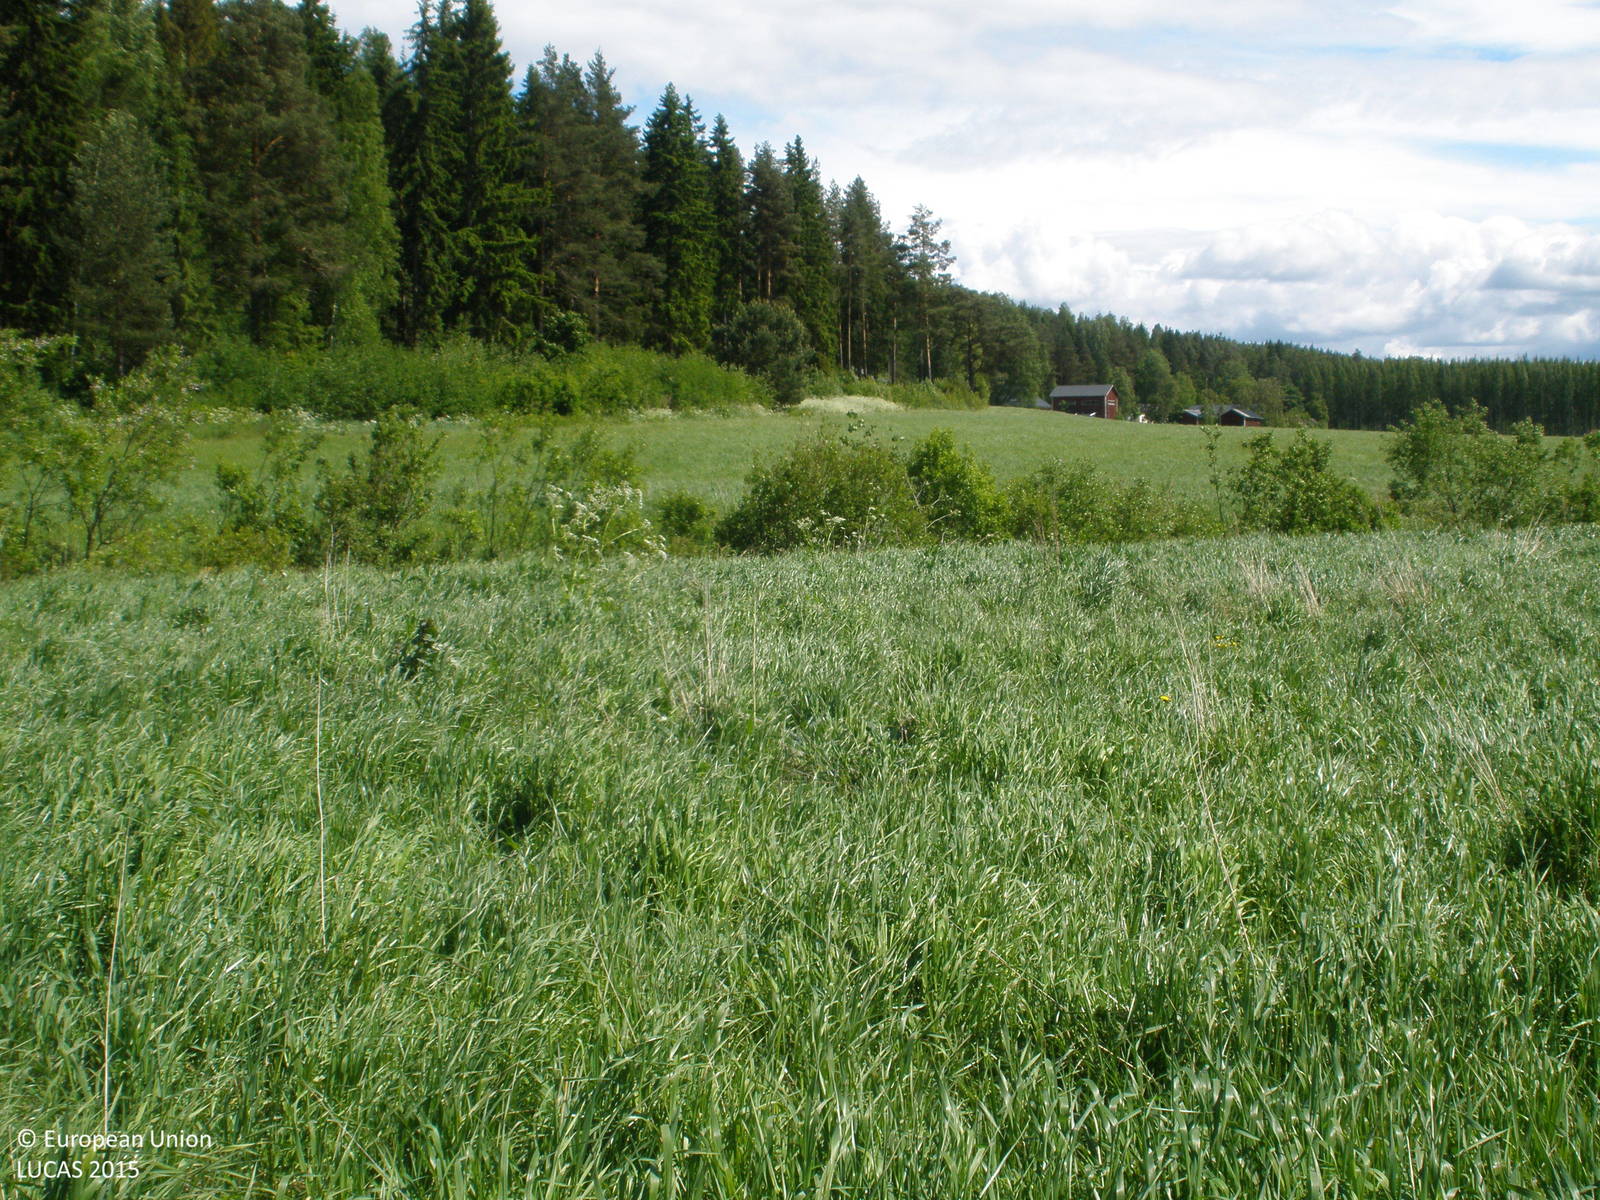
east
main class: Grassland
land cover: Grassland without tree/shrub cover
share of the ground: > 75 %
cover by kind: herbaceous plants 100 %
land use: Agriculture (excluding fallow land and kitchen gardens)
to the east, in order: Grassland without tree/shrub cover; Ditches and canals; Grassland without tree/shrub cover; Shrubland without tree cover; Tracks; Spruce dominated coniferous woodland; Tracks; Spruce dominated coniferous woodland
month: June
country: FI
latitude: 61.1404
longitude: 24.6092
